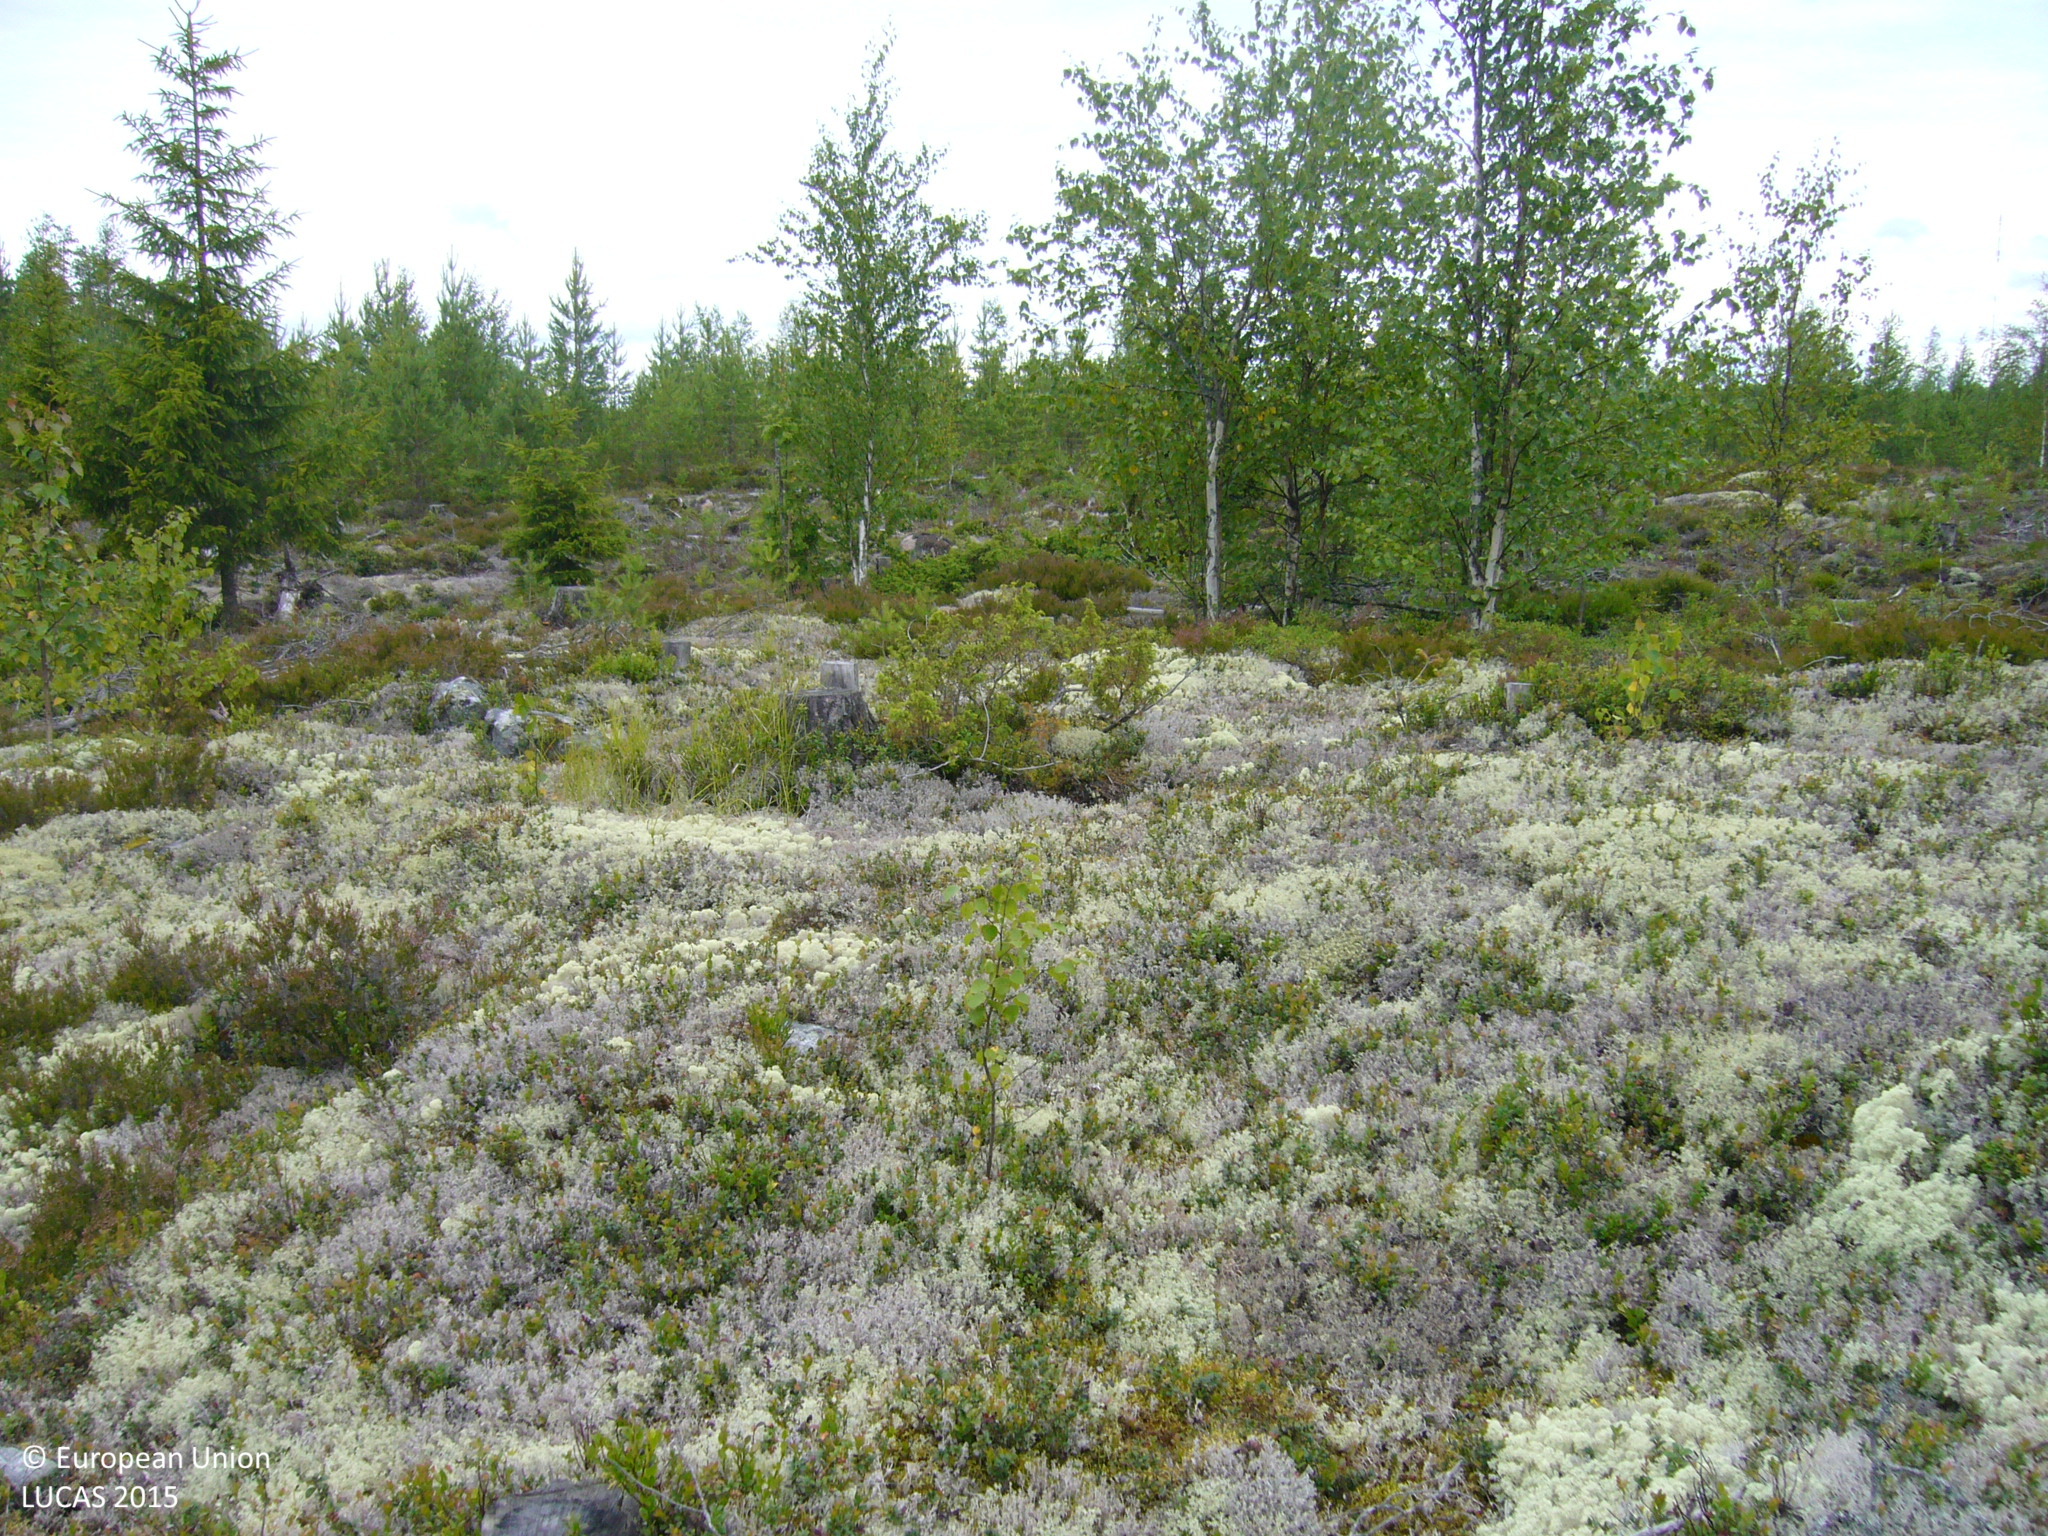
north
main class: Woodland
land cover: Broadleaved woodland
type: boreal forest
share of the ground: 10 - 25 %
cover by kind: lichens and mosses 80 %, broadleaved forest trees 15 %, coniferous forest trees 5 %
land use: Forestry
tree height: < 5 m
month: July
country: FI
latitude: 63.8551
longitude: 25.8286
